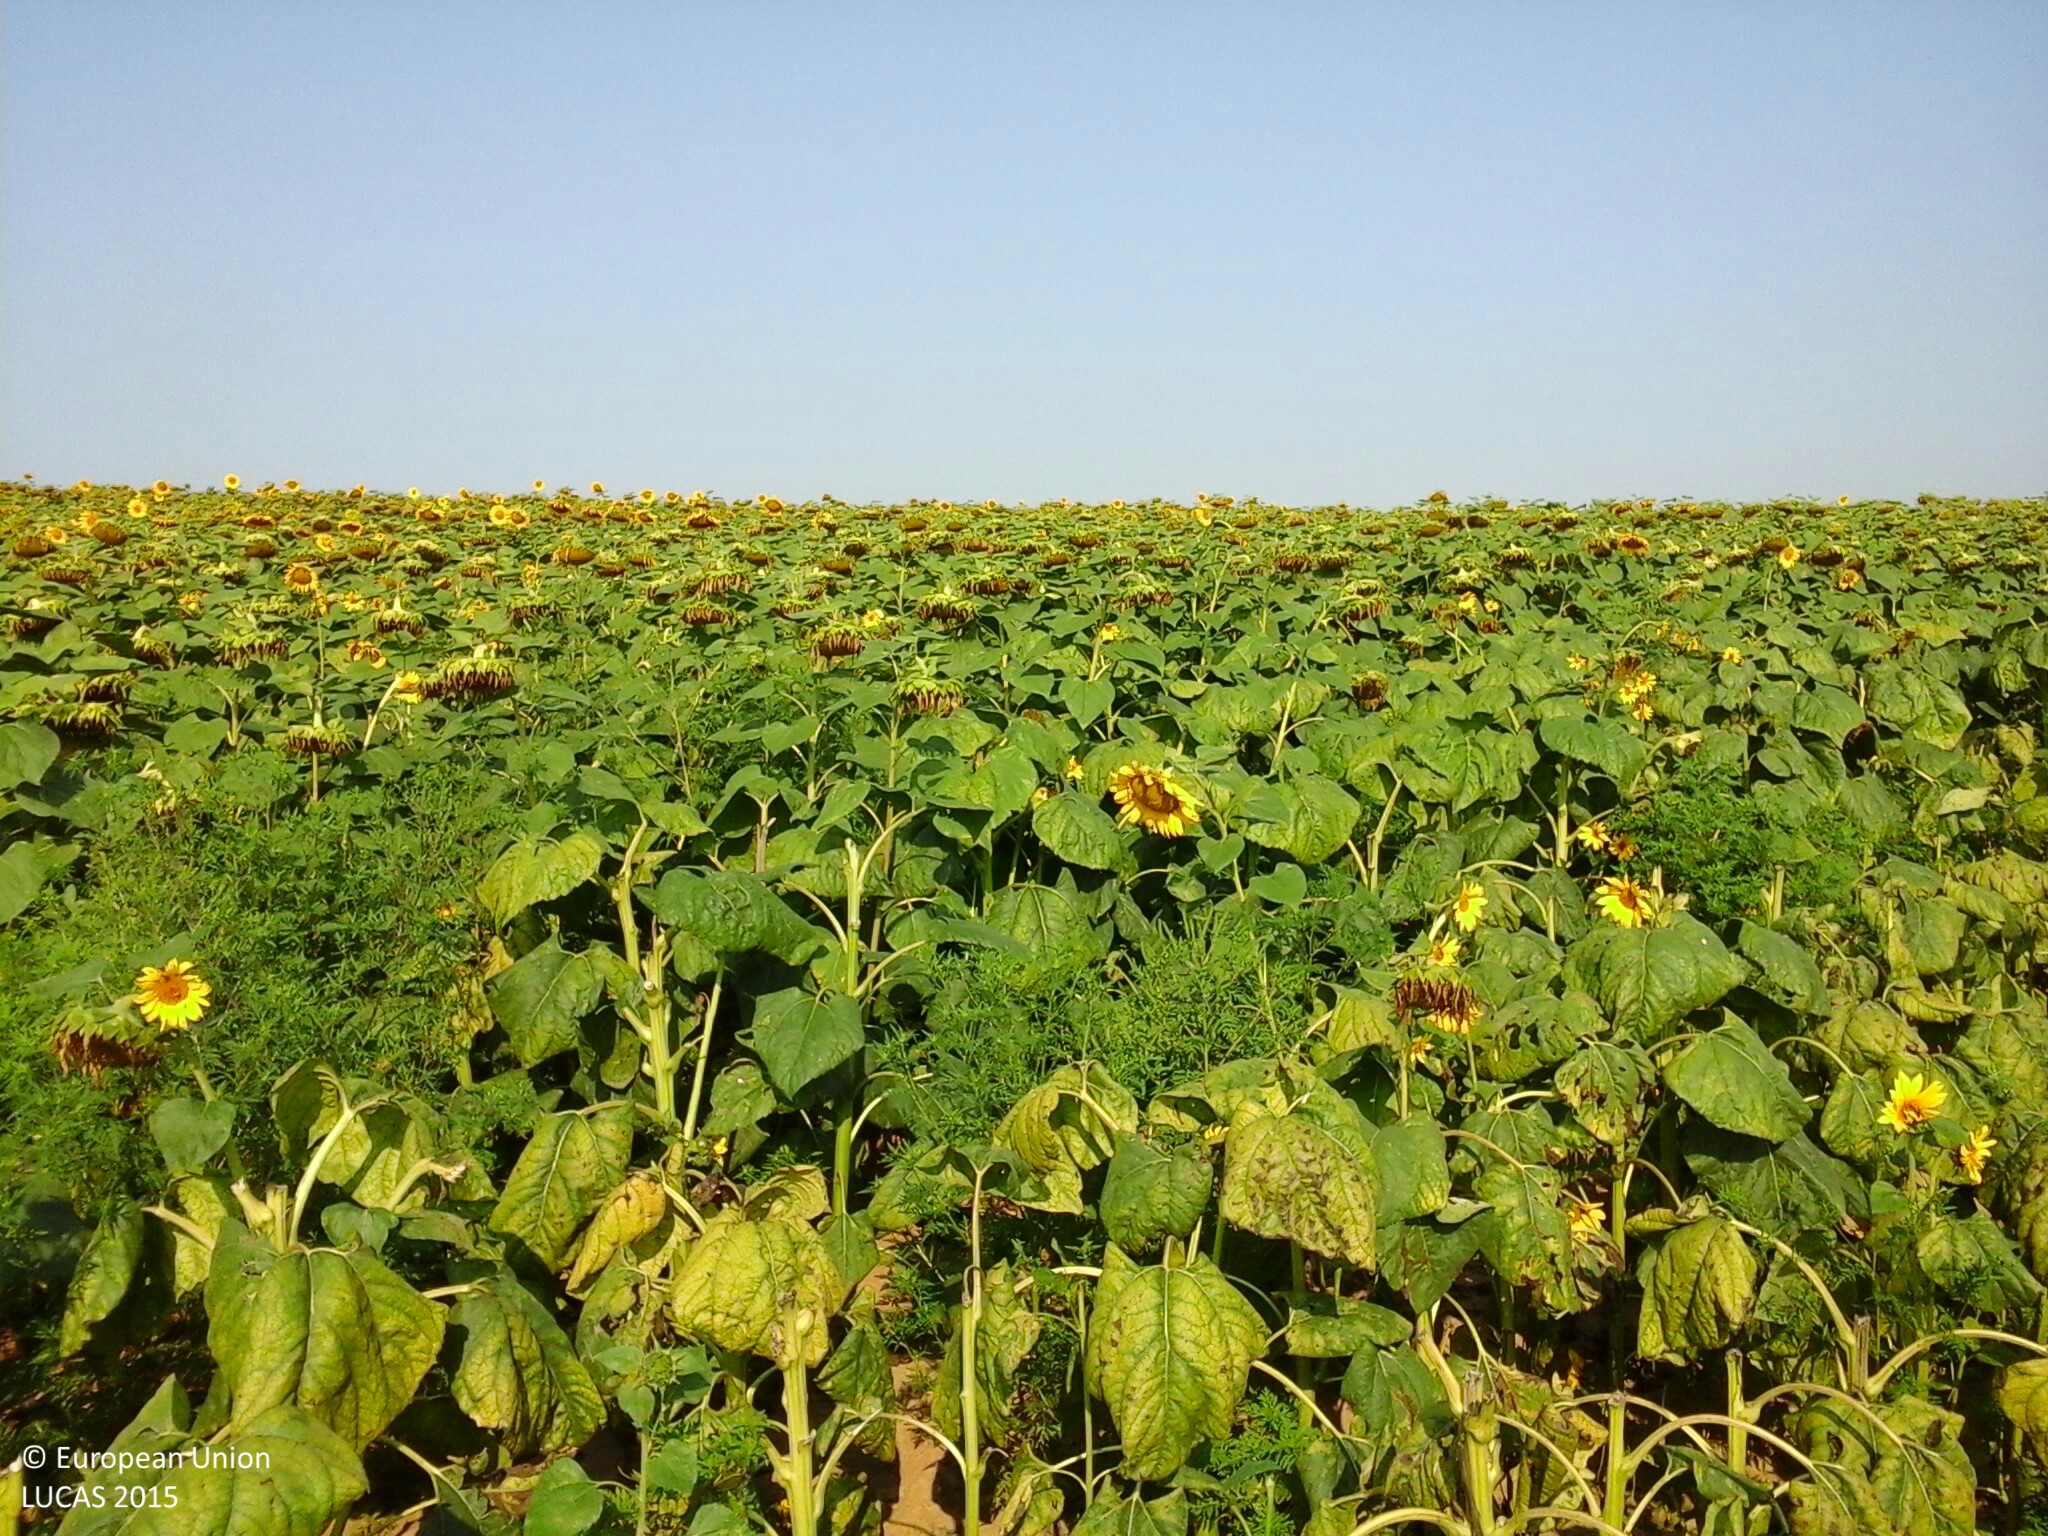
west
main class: Cropland
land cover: Sunflower
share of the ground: > 75 %
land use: Agriculture (excluding fallow land and kitchen gardens)
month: August
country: HU
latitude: 46.6074
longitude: 18.0637
